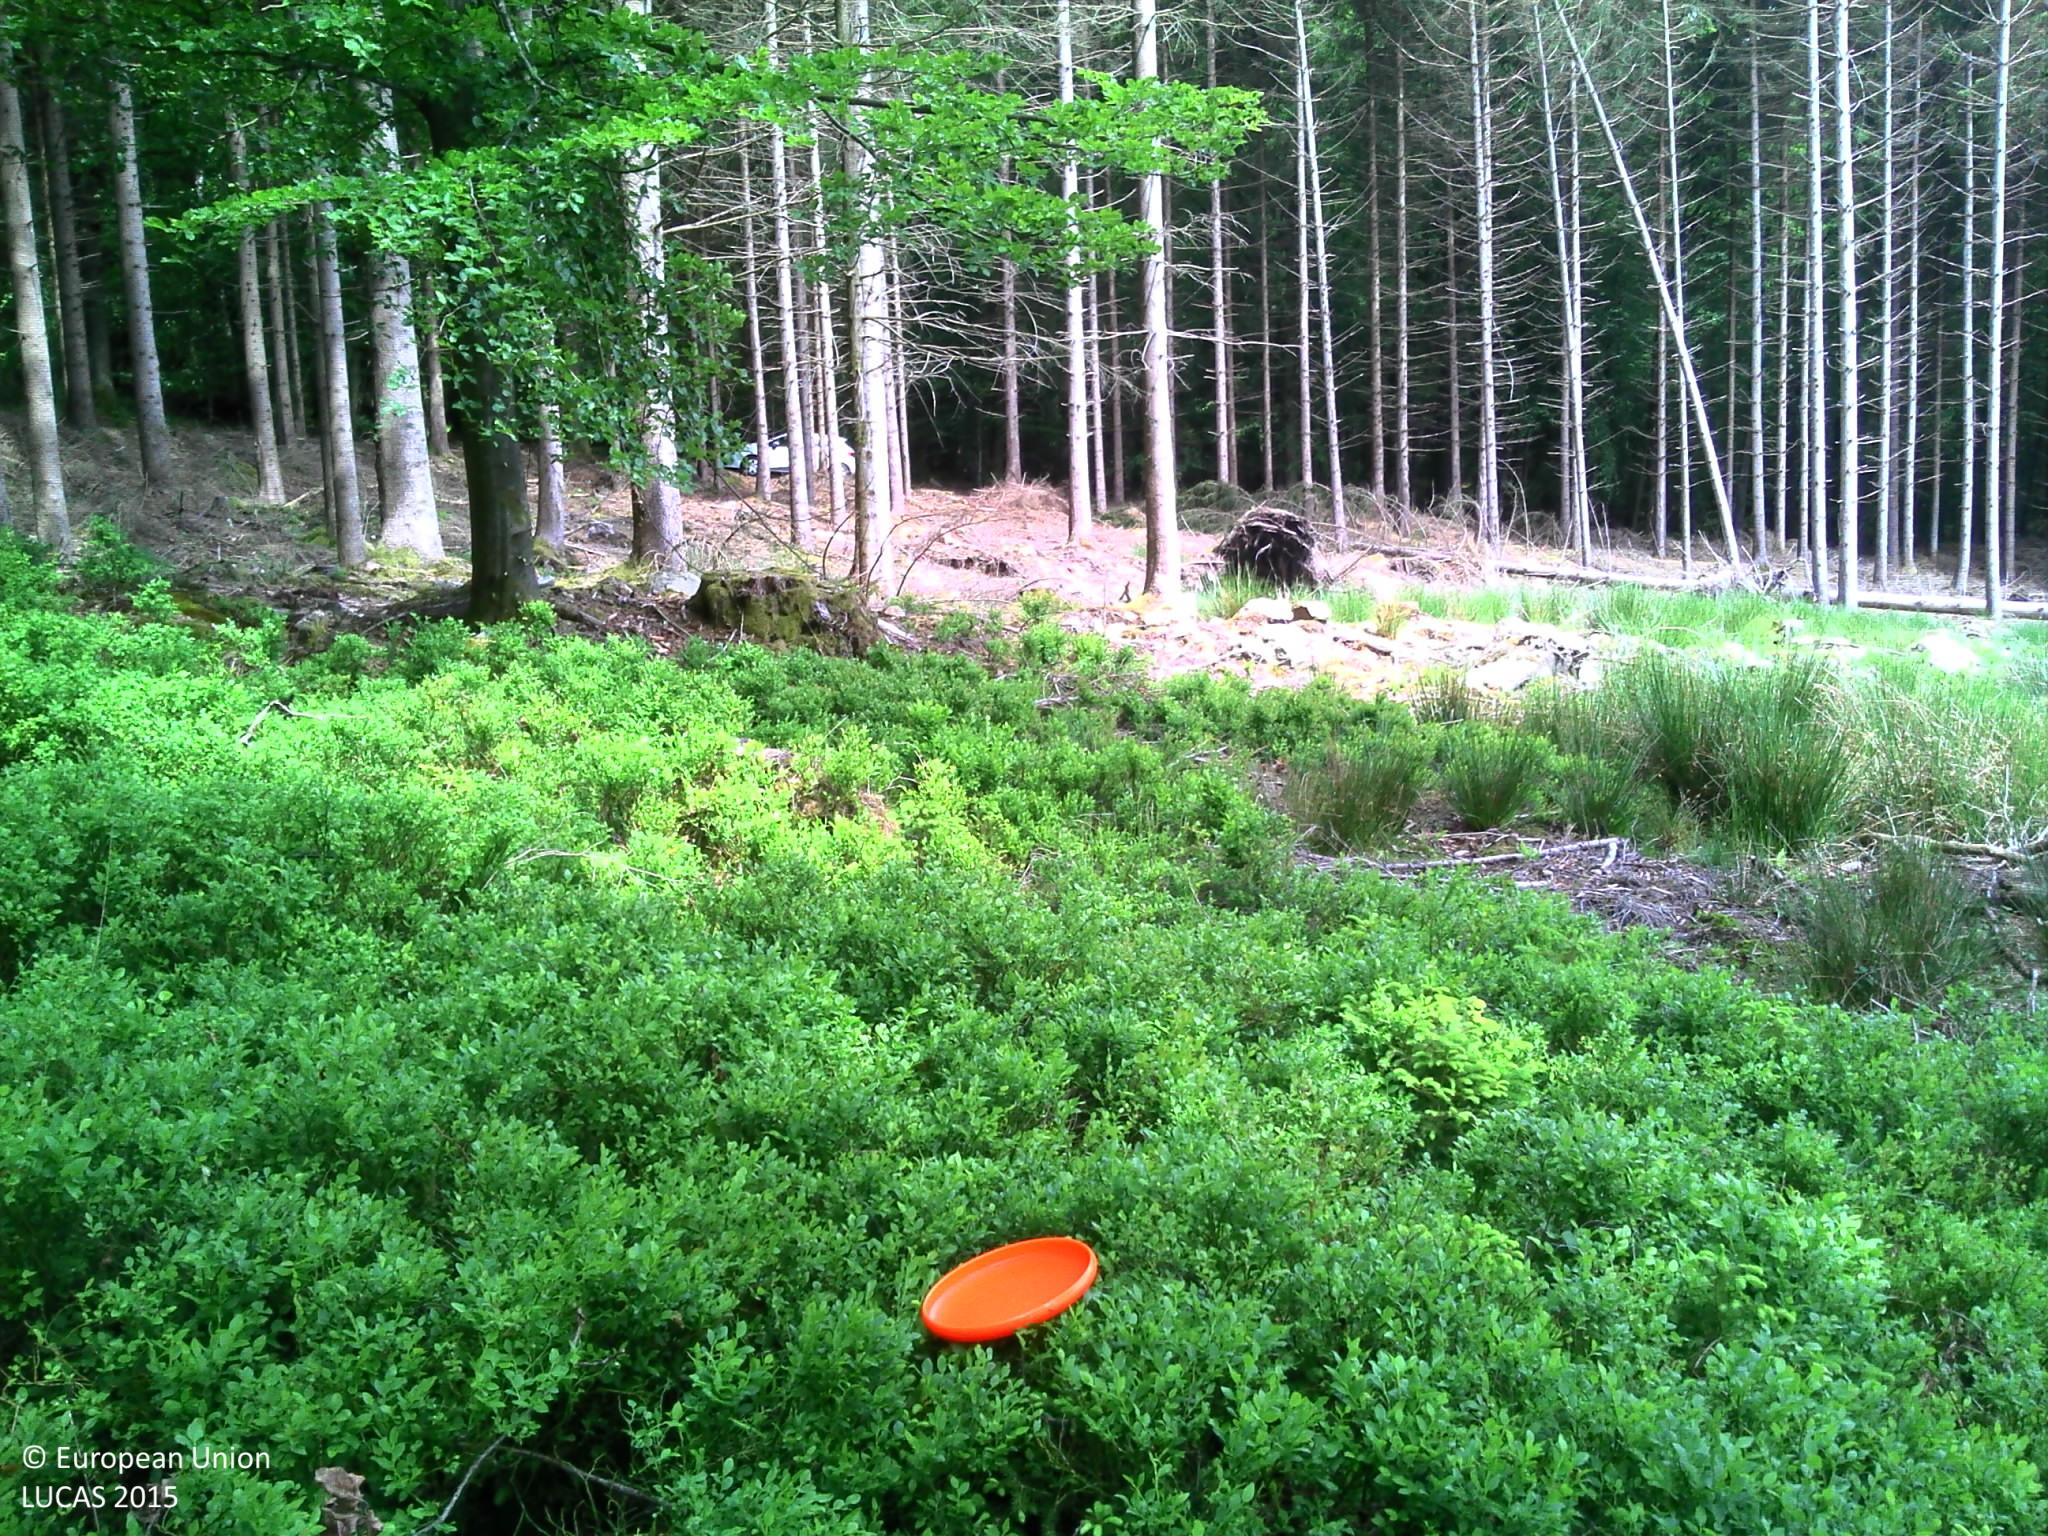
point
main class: Shrubland
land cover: Shrubland without tree cover
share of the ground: > 75 %
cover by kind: herbaceous plants 45 %, shrubs 25 %, unconsolidated bare surface 15 %
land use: Forestry
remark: Clear cut
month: June
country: BE
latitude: 50.3578
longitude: 5.7678
